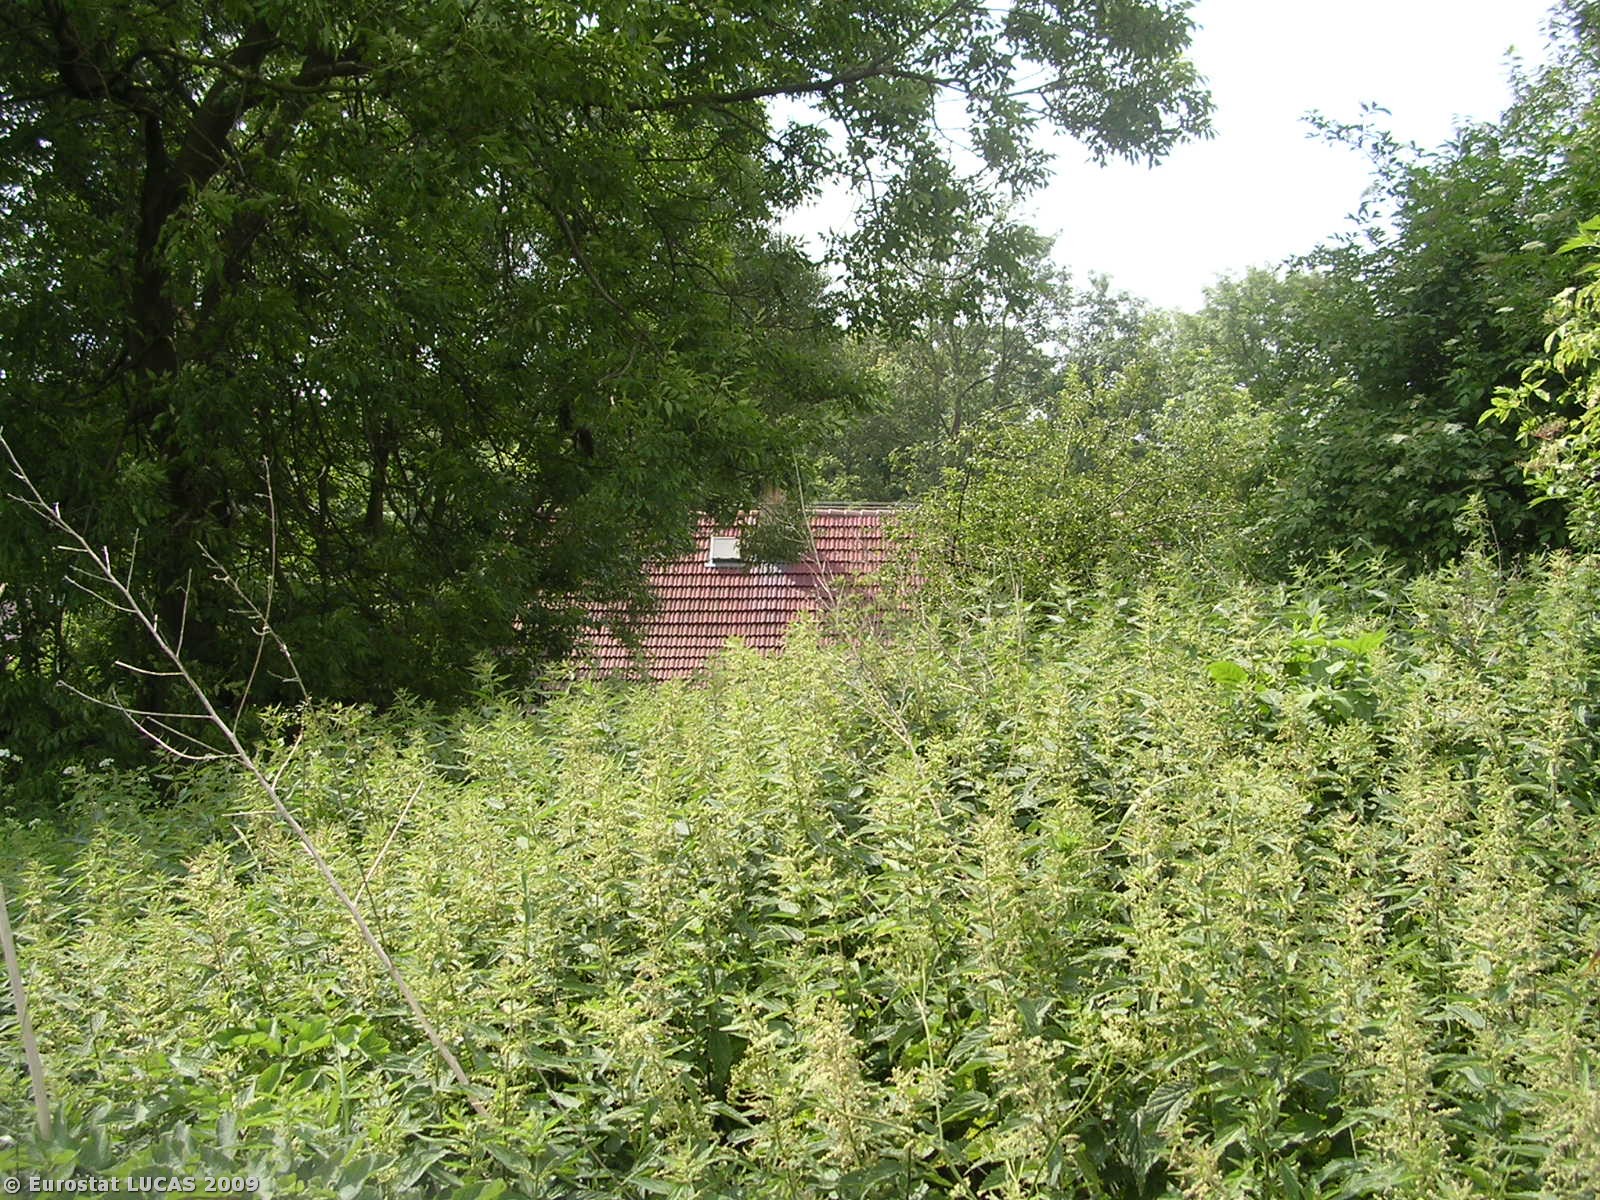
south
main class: Grassland
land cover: Grassland without tree/shrub cover
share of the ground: > 75 %
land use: Agriculture (excluding fallow land and kitchen gardens)
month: June
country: CZ
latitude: 50.6608
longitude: 14.3162
